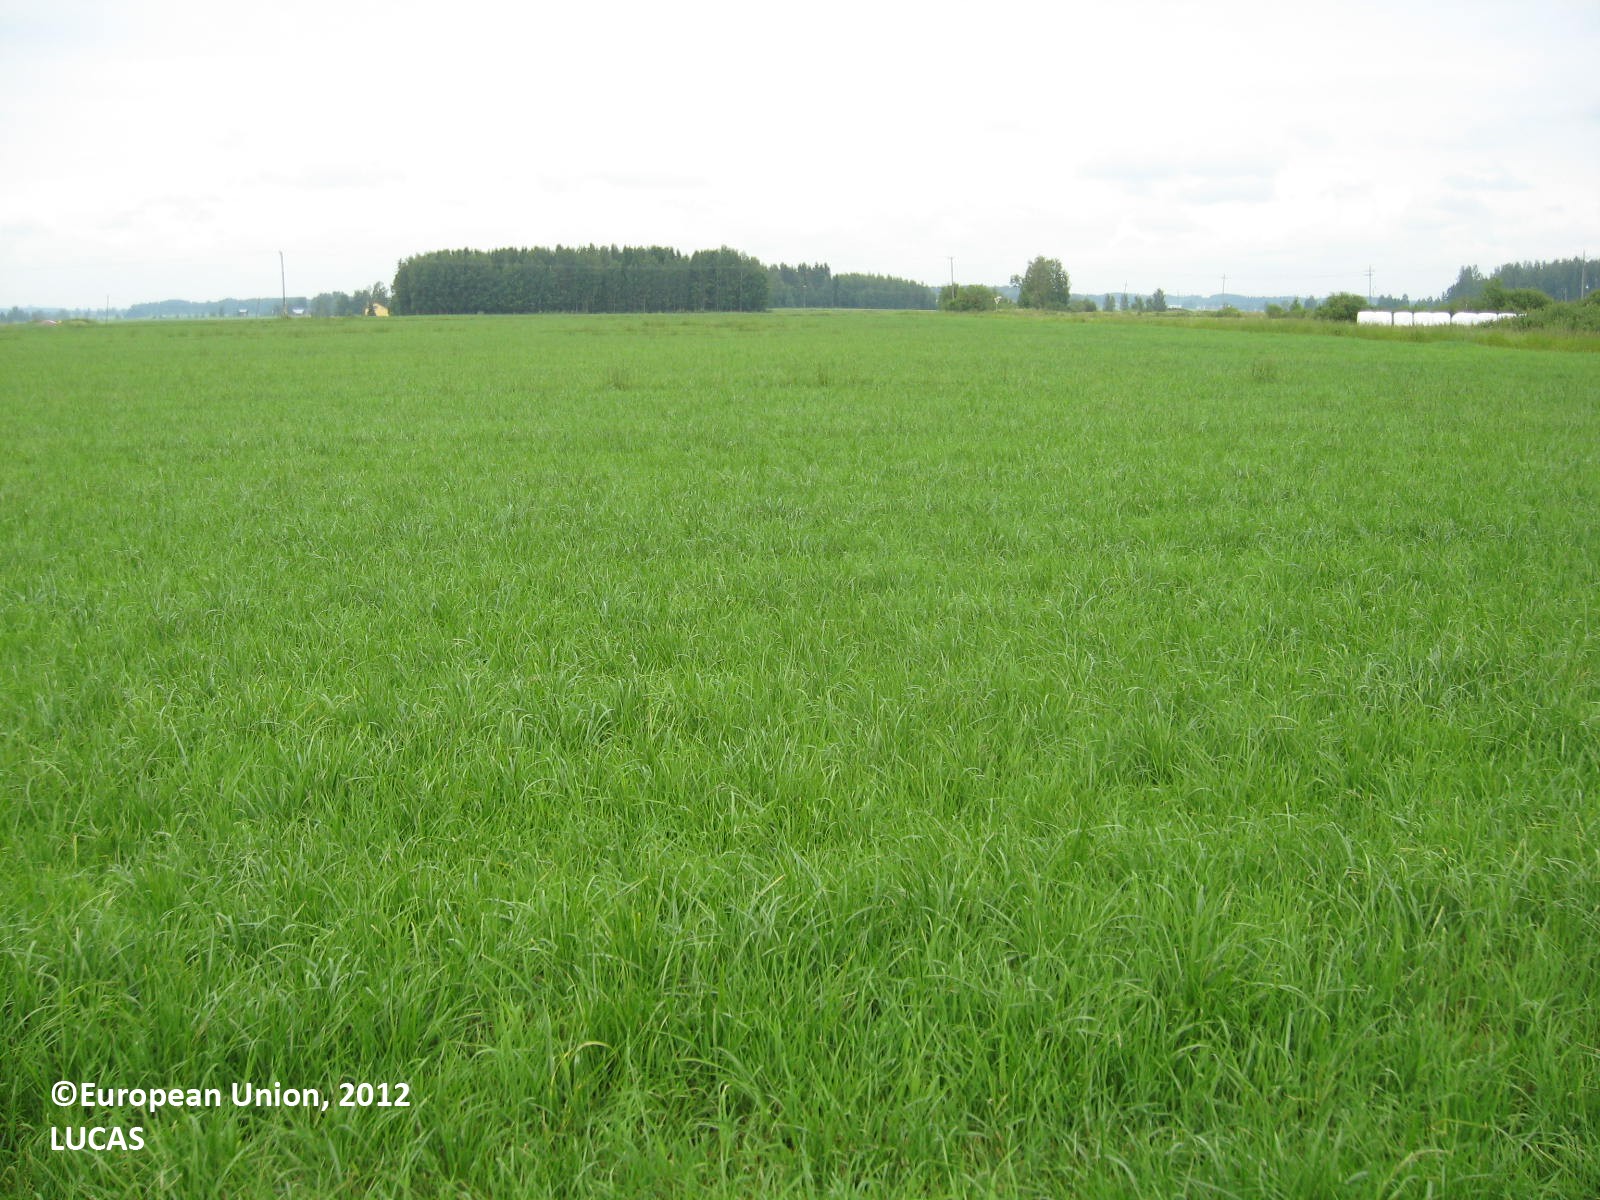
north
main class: Cropland
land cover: Temporary grasslands
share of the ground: > 75 %
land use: Agriculture (excluding fallow land and kitchen gardens)
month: July
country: FI
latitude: 62.4485
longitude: 22.7924
